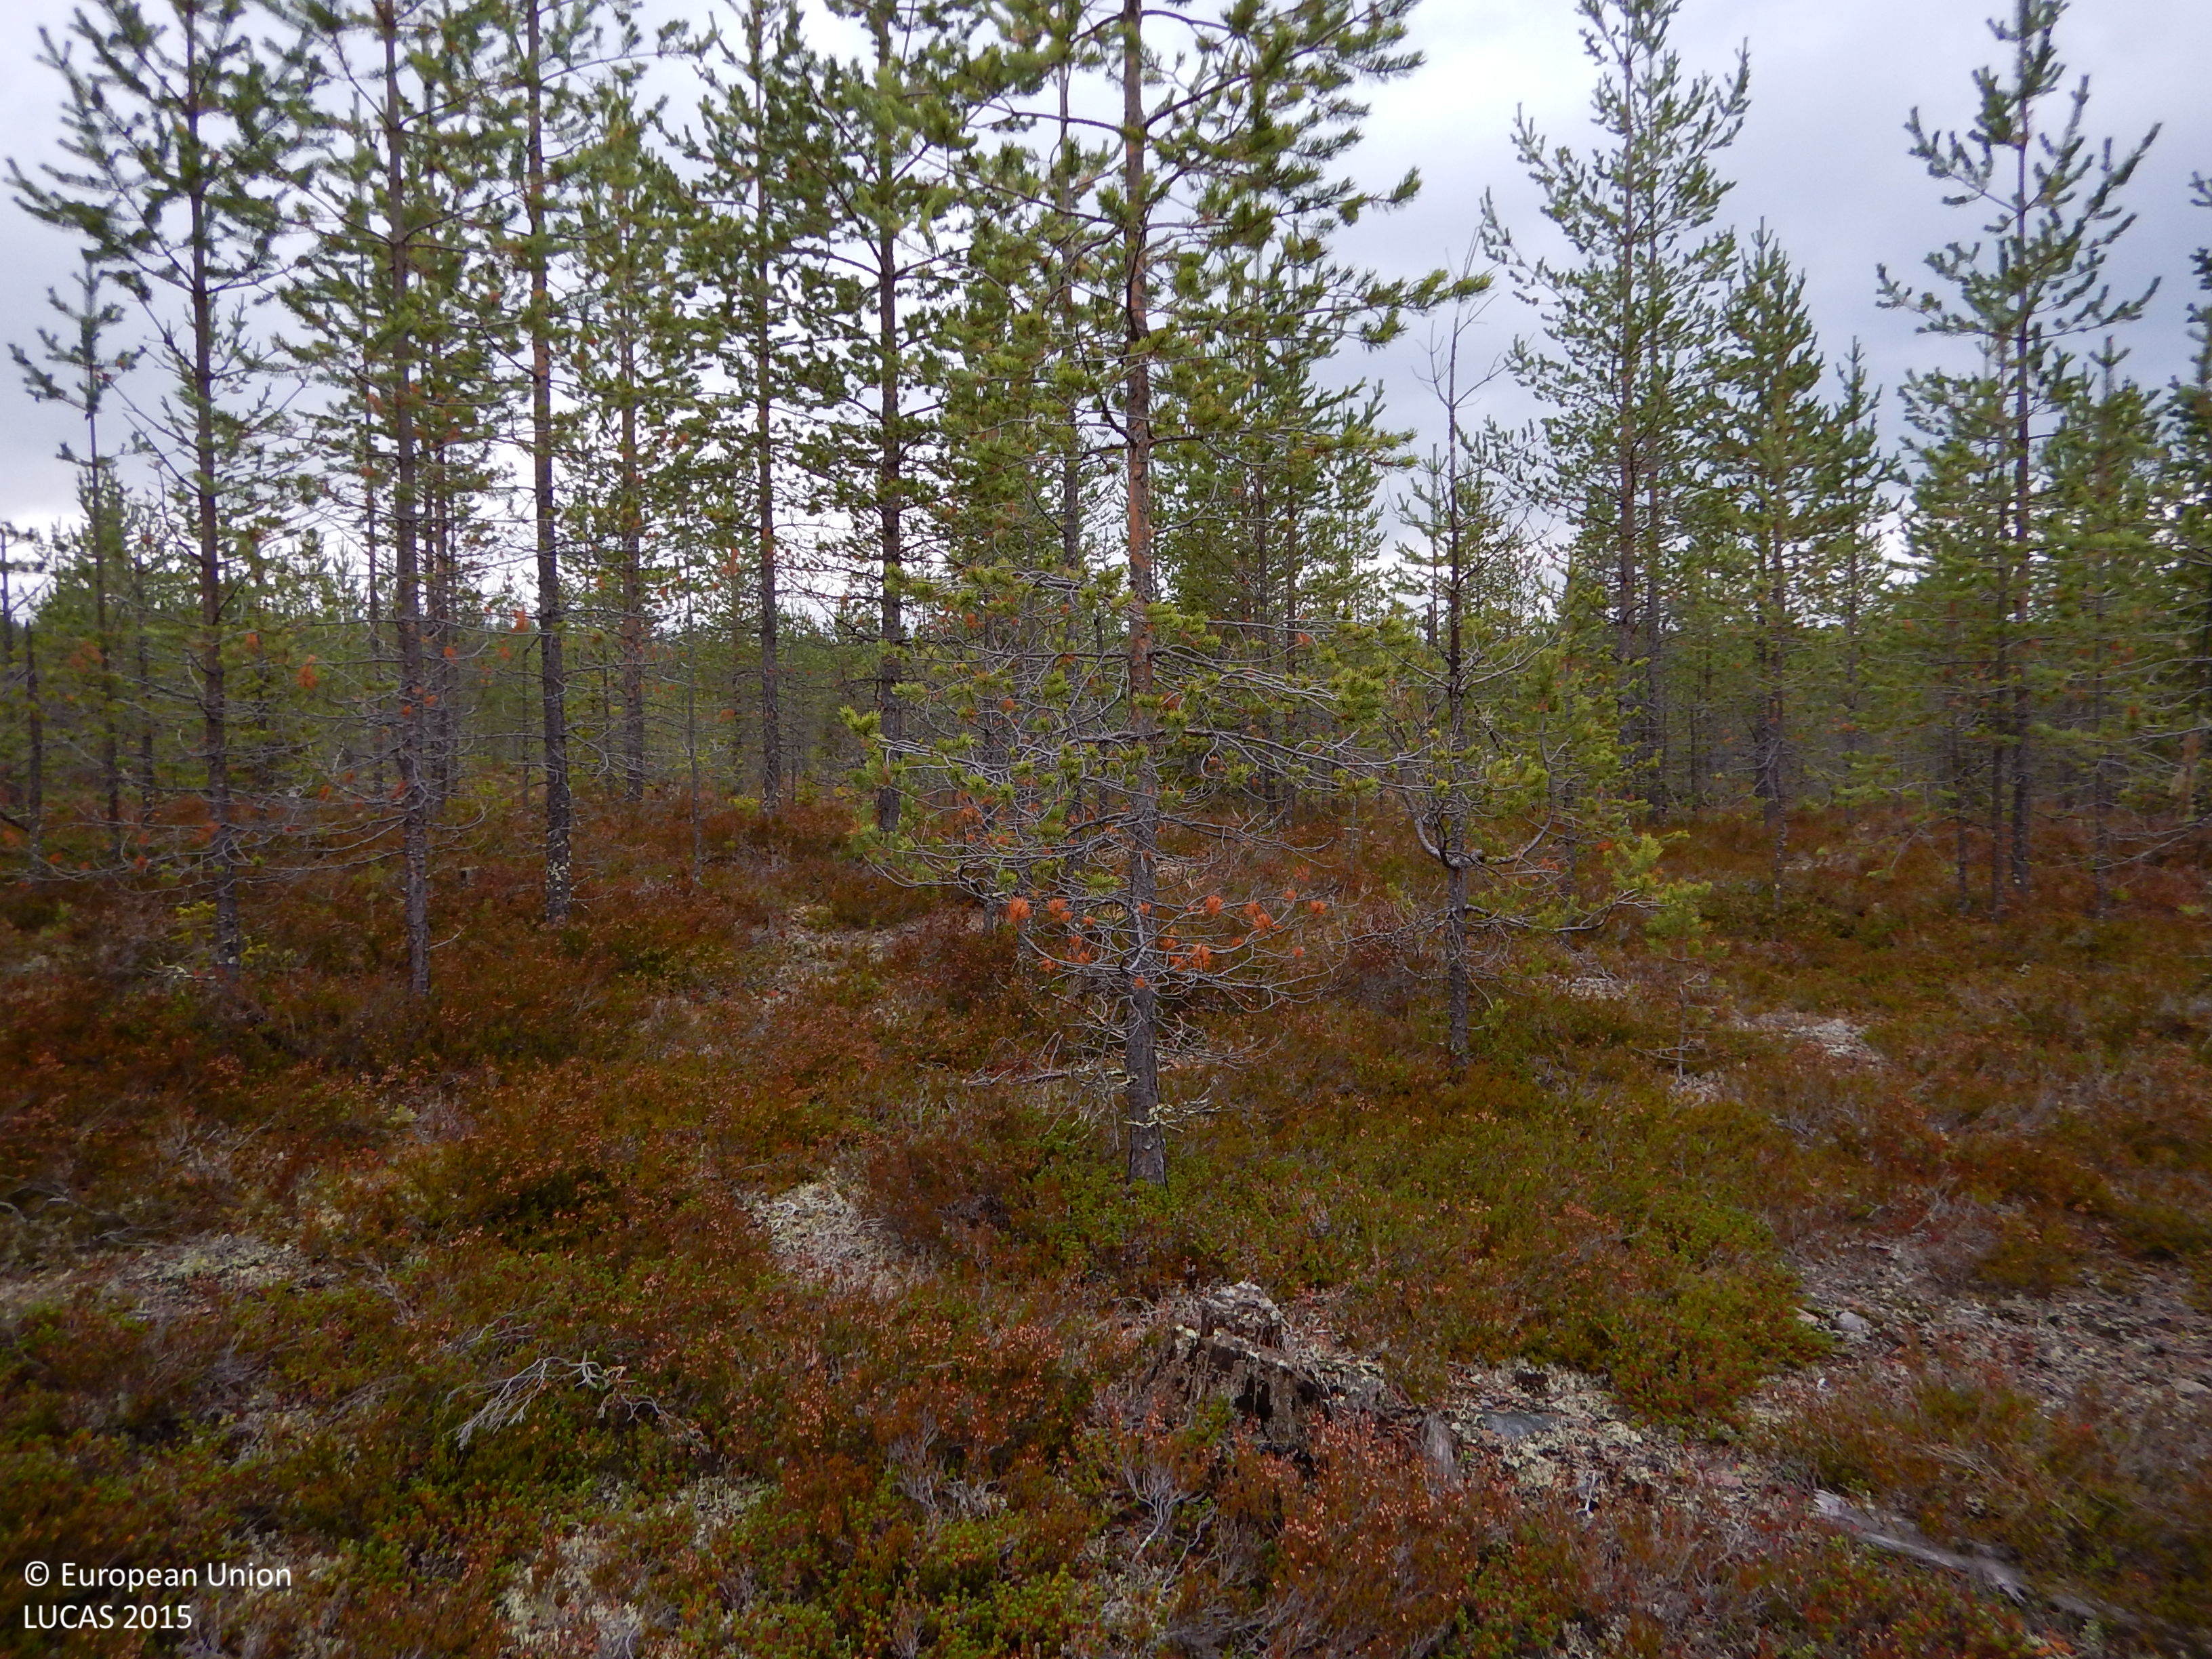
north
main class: Woodland
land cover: Pine dominated coniferous woodland
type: boreal forest
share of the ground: 50 - 75 %
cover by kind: coniferous forest trees 60 %, shrubs 15 %, lichens and mosses 15 %, herbaceous plants 5 %, unconsolidated bare surface 5 %
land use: Forestry
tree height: > 5 m
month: September
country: SE
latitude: 65.0790
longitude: 19.1749
